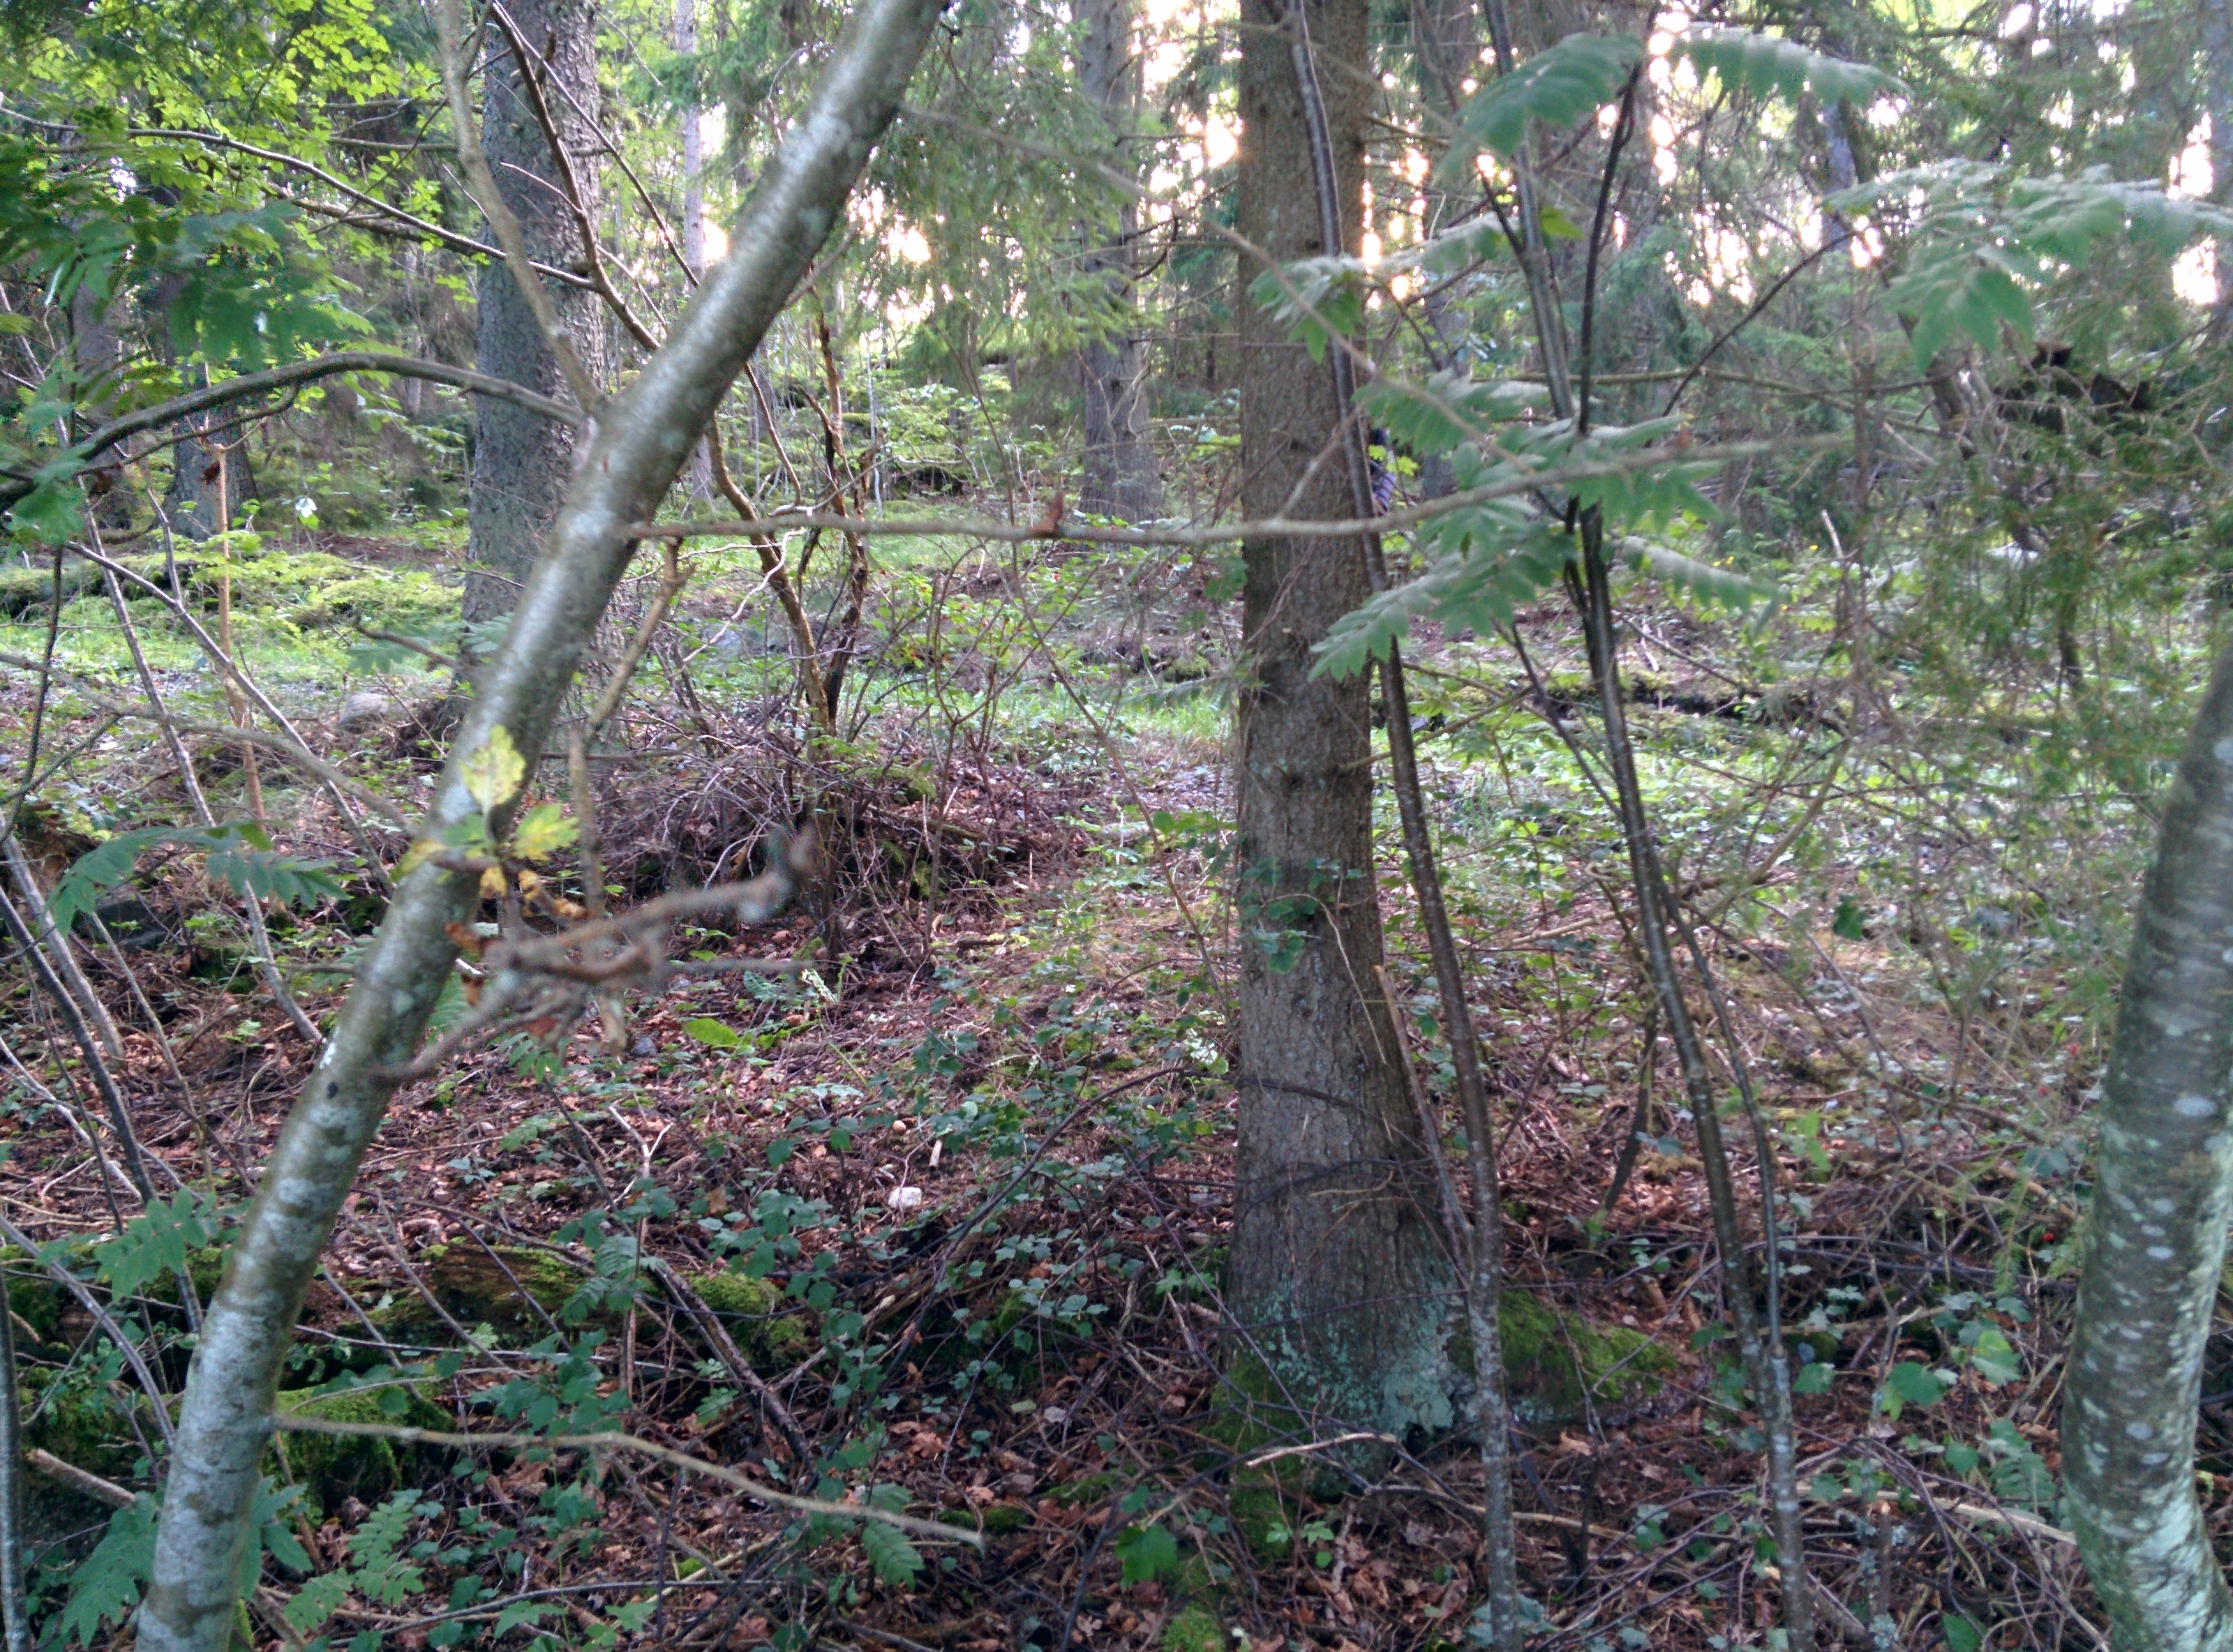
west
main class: Woodland
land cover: Broadleaved woodland
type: hemiboreal forest and nemoral coniferous forest and mixed broadleaved-coniferous forest
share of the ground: > 75 %
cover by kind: broadleaved forest trees 75 %, coniferous forest trees 10 %, unconsolidated bare surface 10 %, herbaceous plants 5 %
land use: Forestry
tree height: > 5 m
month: August
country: SE
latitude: 58.9391
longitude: 17.6965
